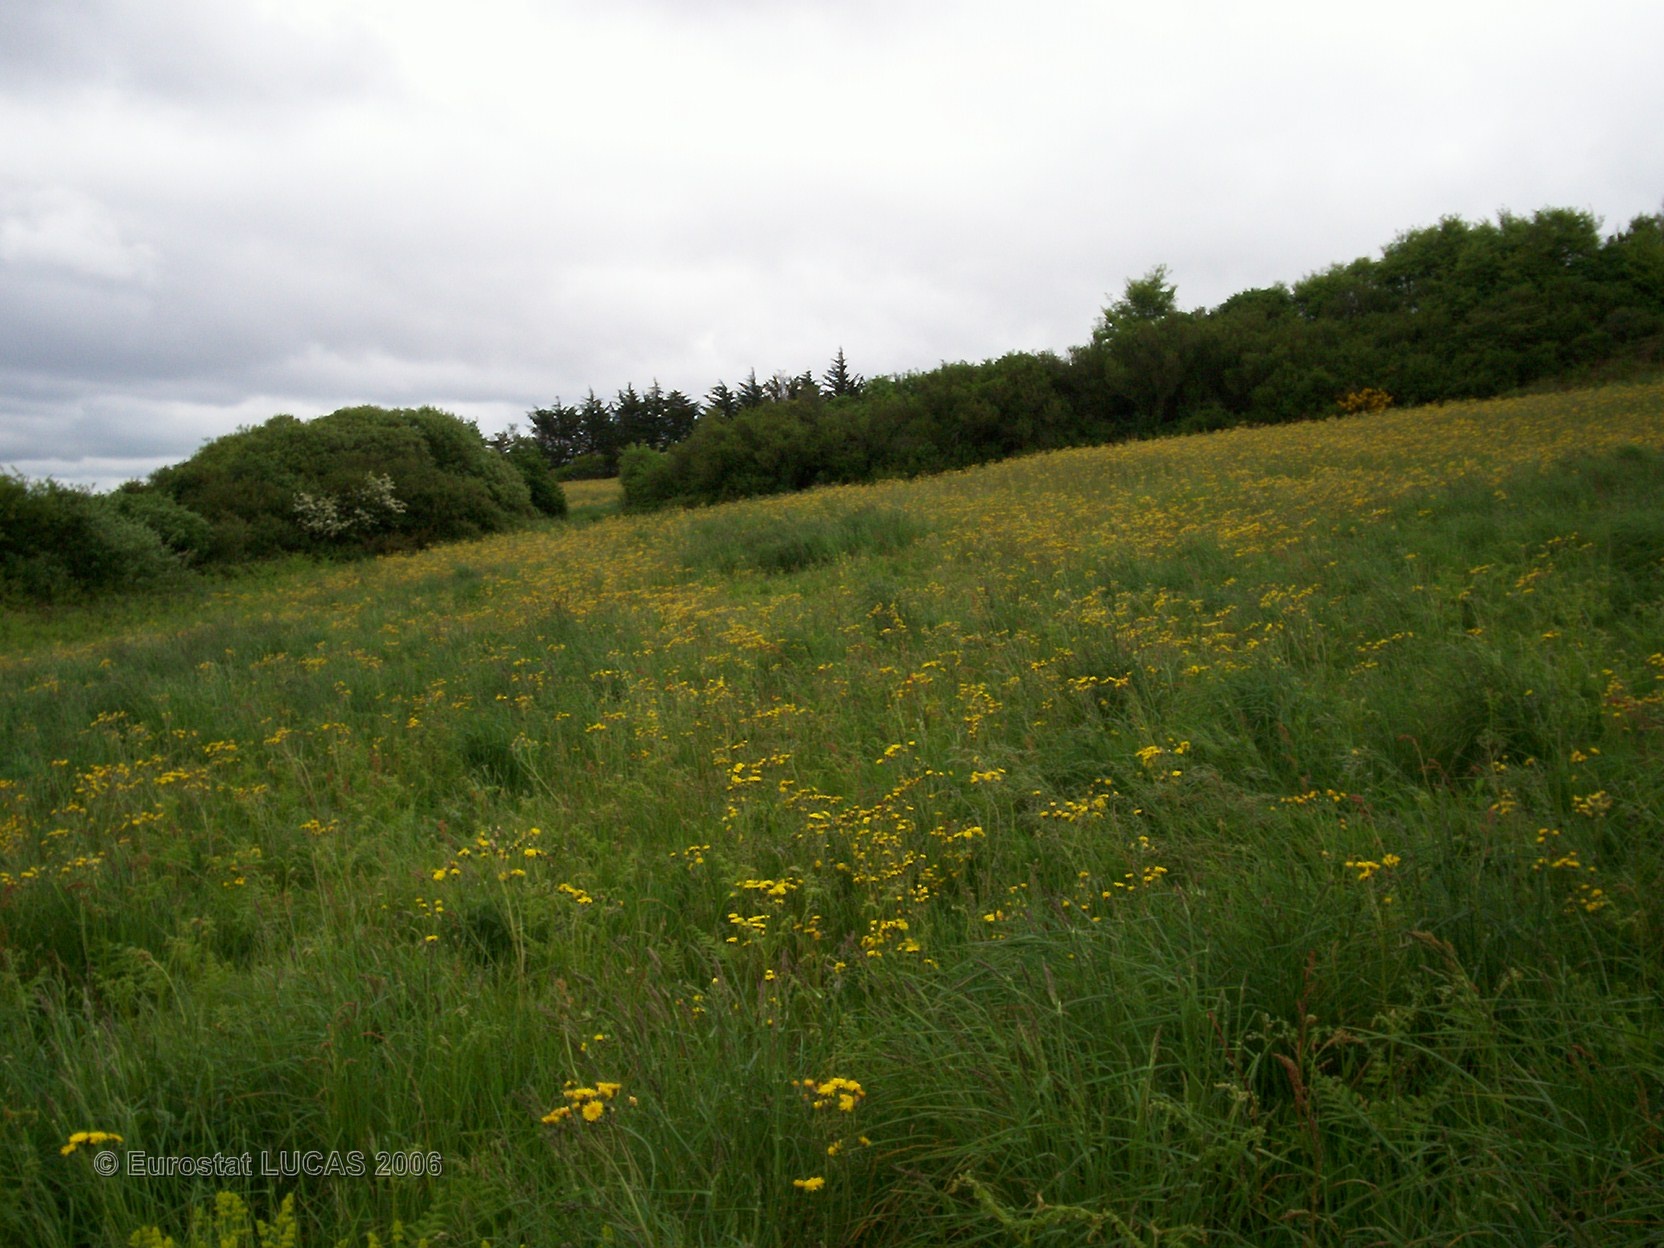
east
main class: Grassland
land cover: Grassland without tree/shrub cover
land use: Agriculture (excluding fallow land and kitchen gardens)
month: May
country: FR
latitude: 48.6941
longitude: -3.7101
